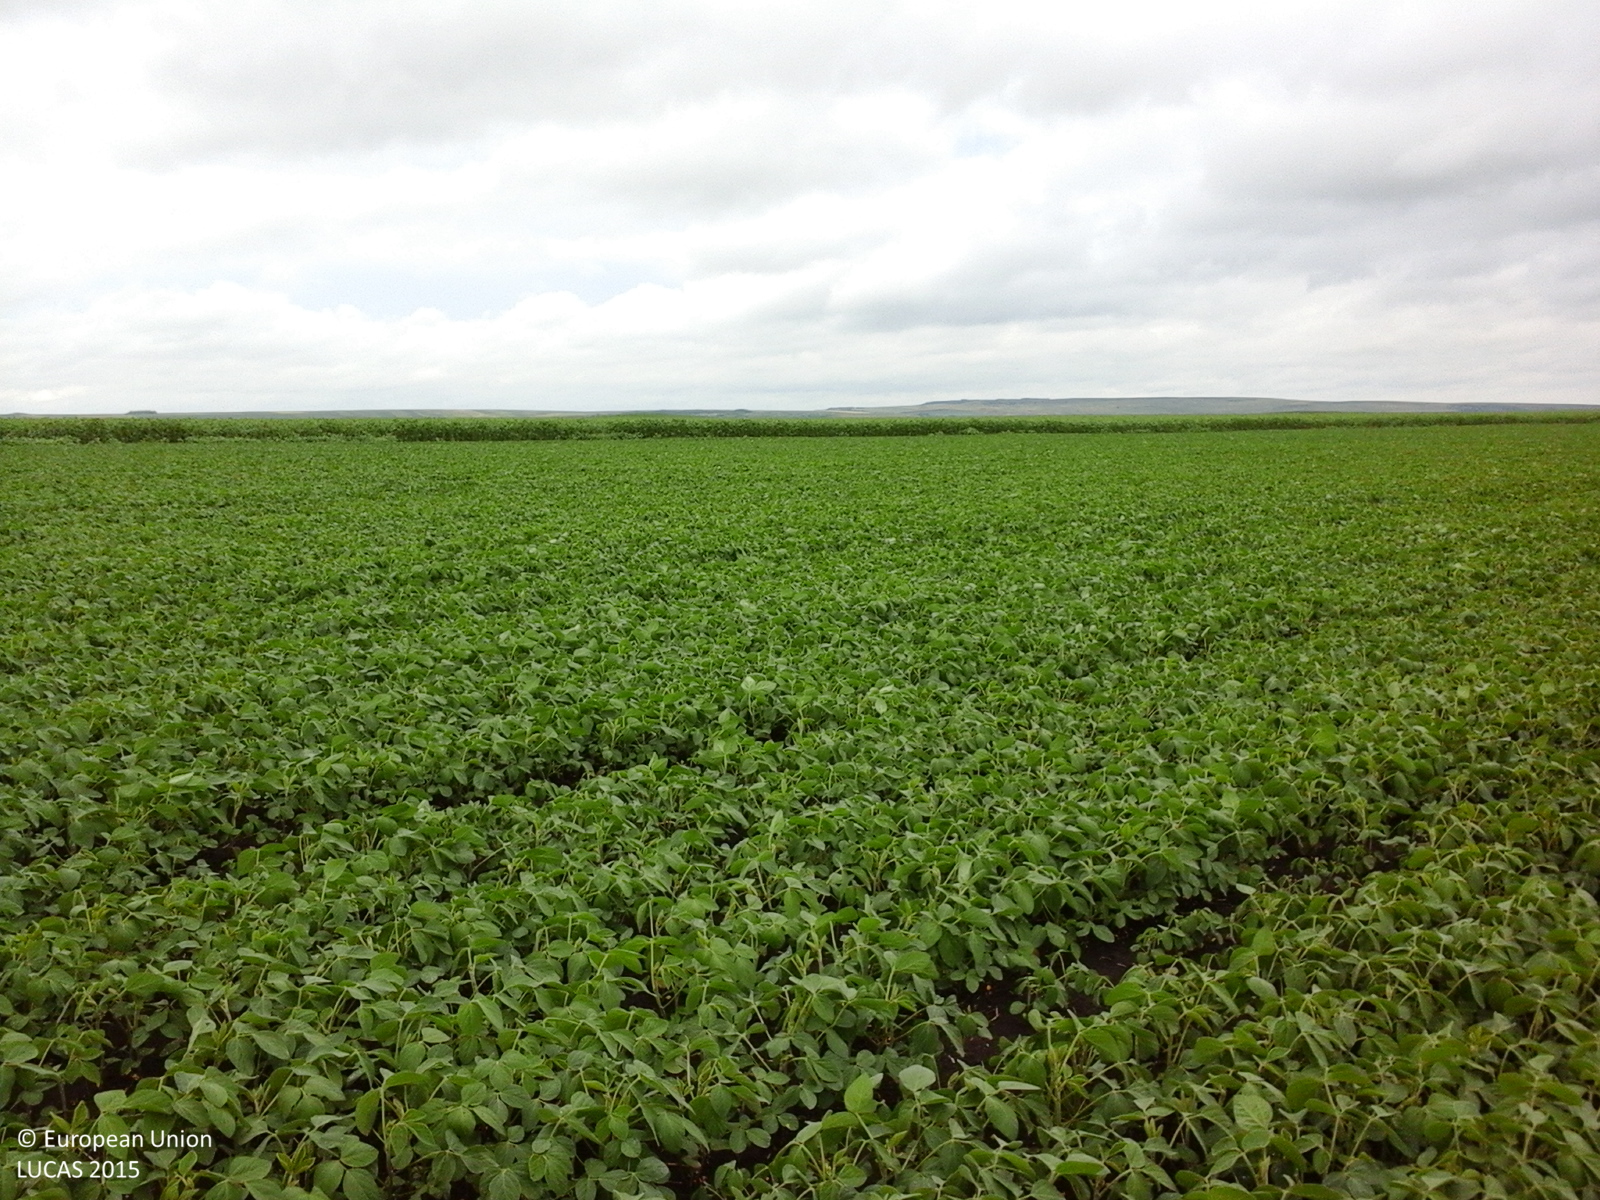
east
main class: Cropland
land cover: Soya
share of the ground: > 75 %
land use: Agriculture (excluding fallow land and kitchen gardens)
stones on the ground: < 10 %
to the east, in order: Soya; Sunflower
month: June
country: RO
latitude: 47.9823
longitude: 26.4771
